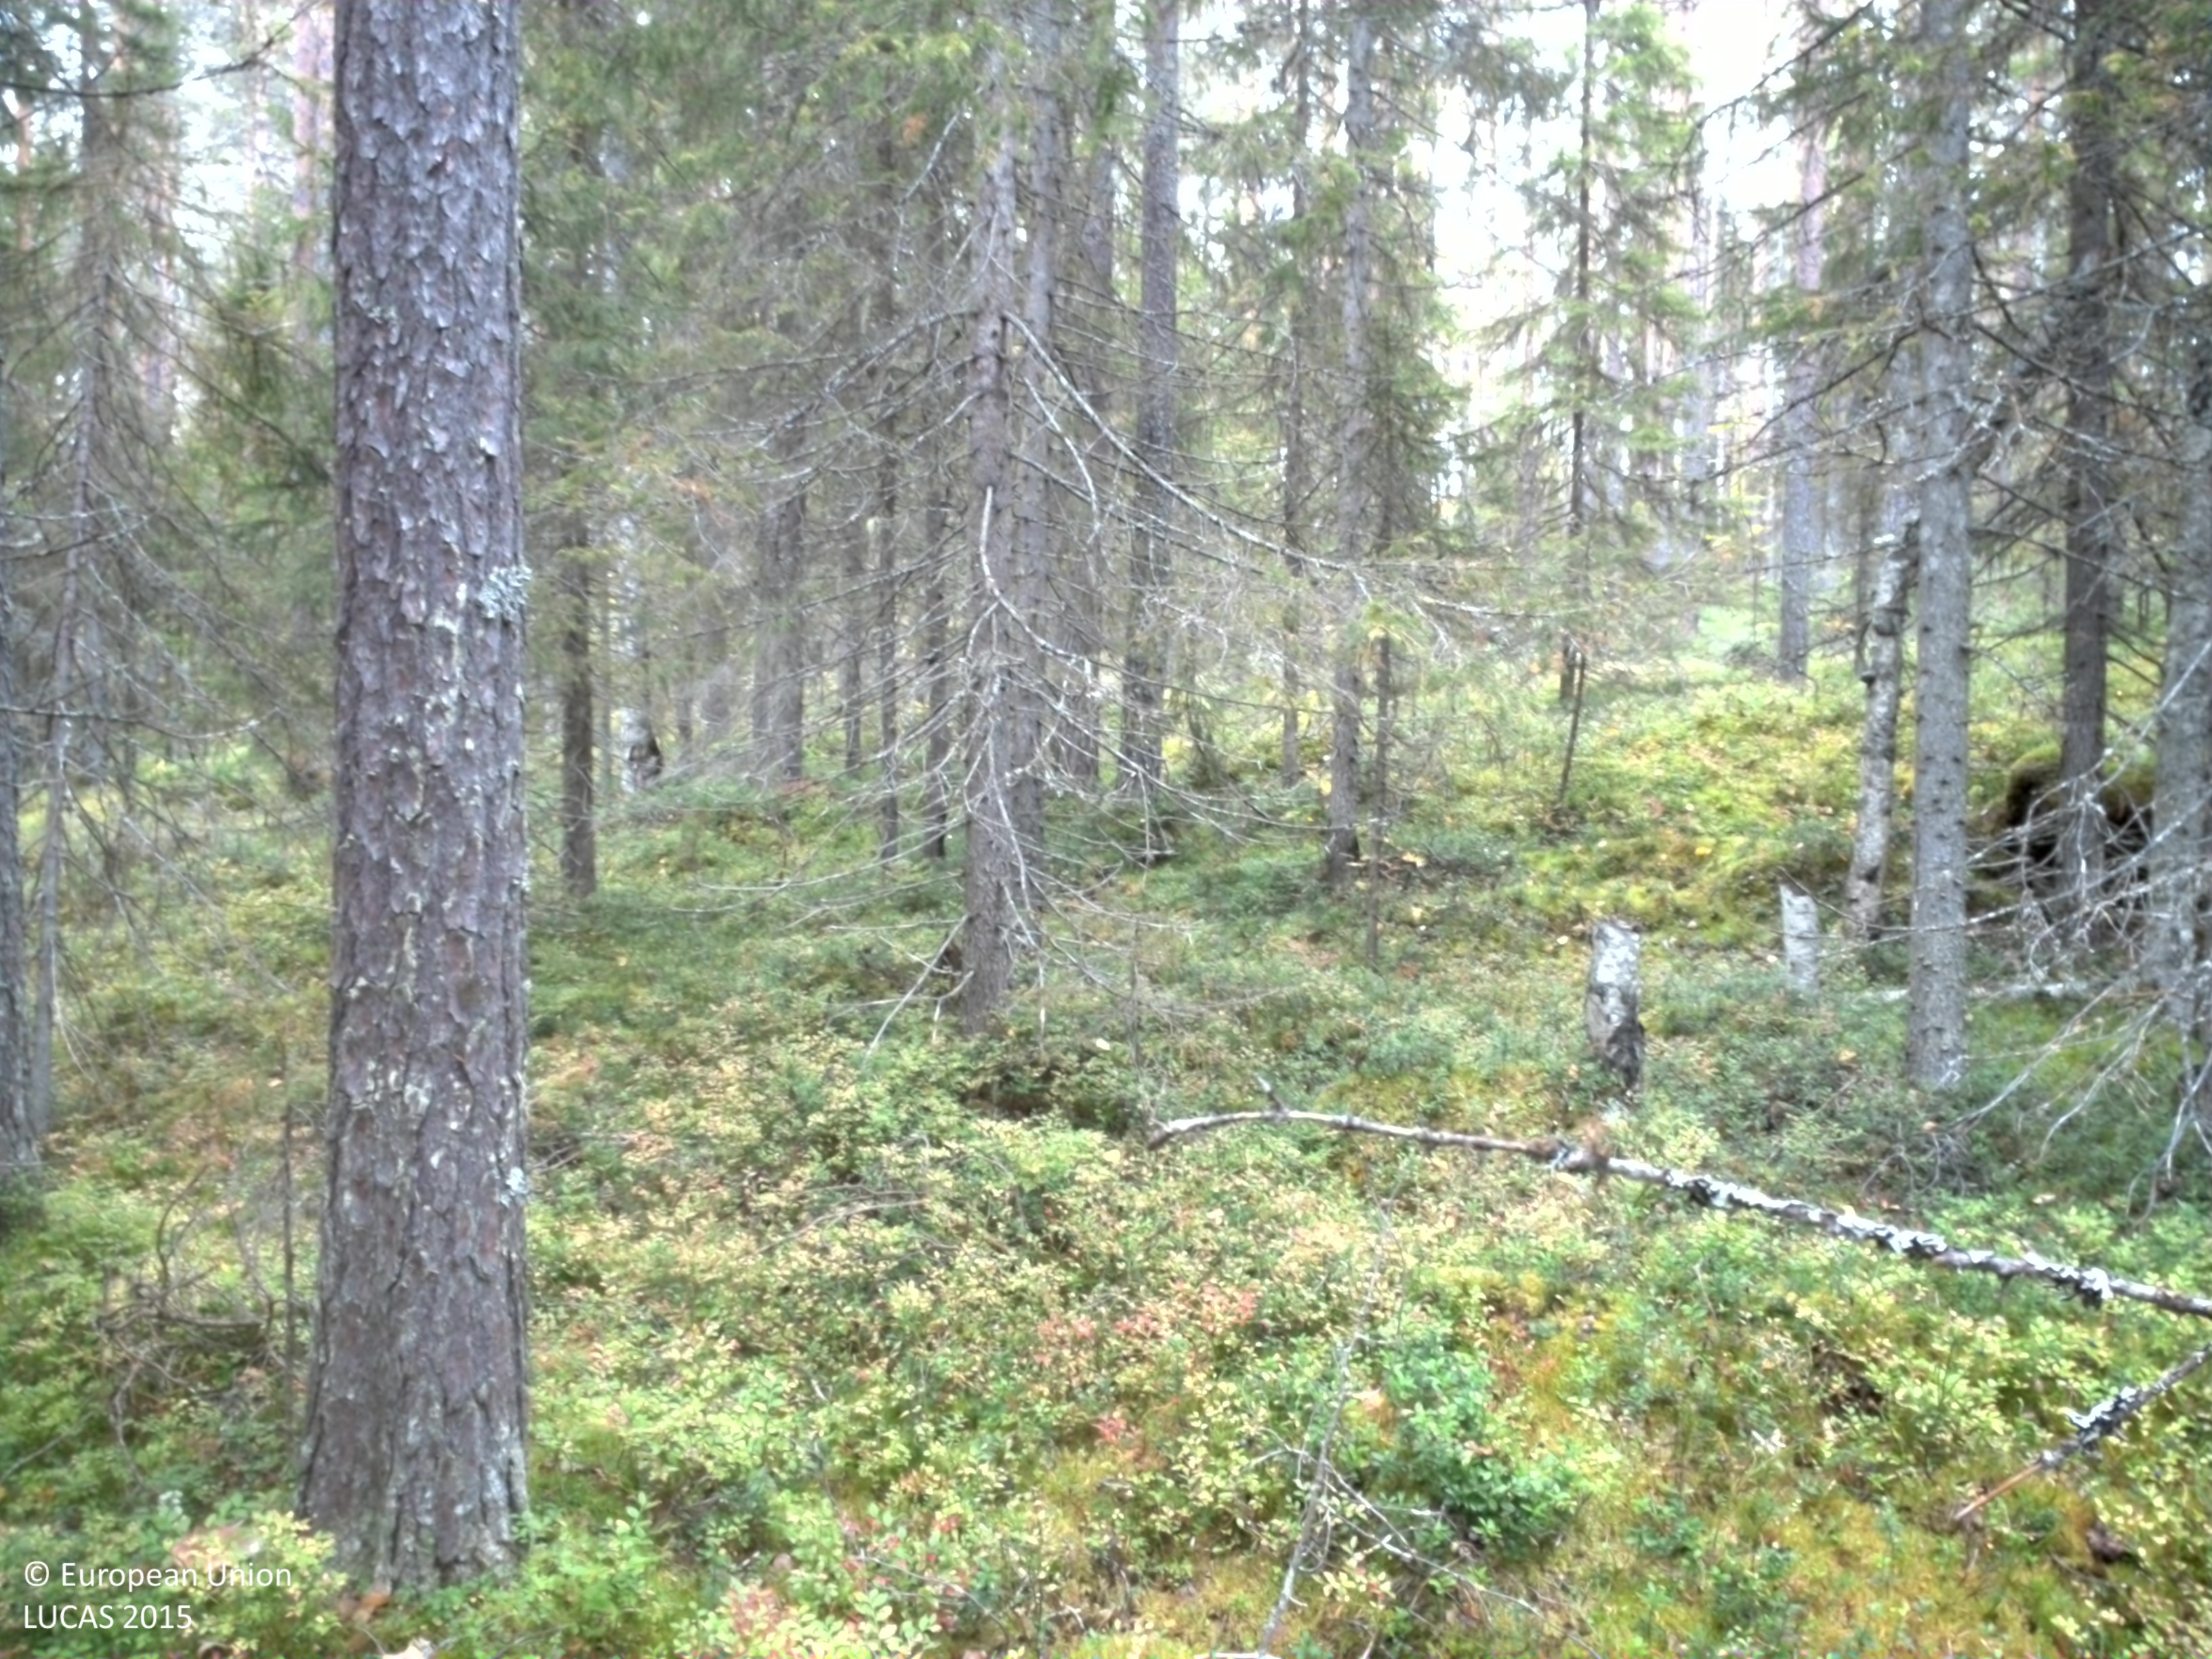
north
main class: Woodland
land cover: Pine dominated coniferous woodland
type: boreal forest
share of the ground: 25 - 50 %
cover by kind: shrubs 65 %, coniferous forest trees 35 %
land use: Forestry
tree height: > 5 m
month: September
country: SE
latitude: 65.8594
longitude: 21.8279
